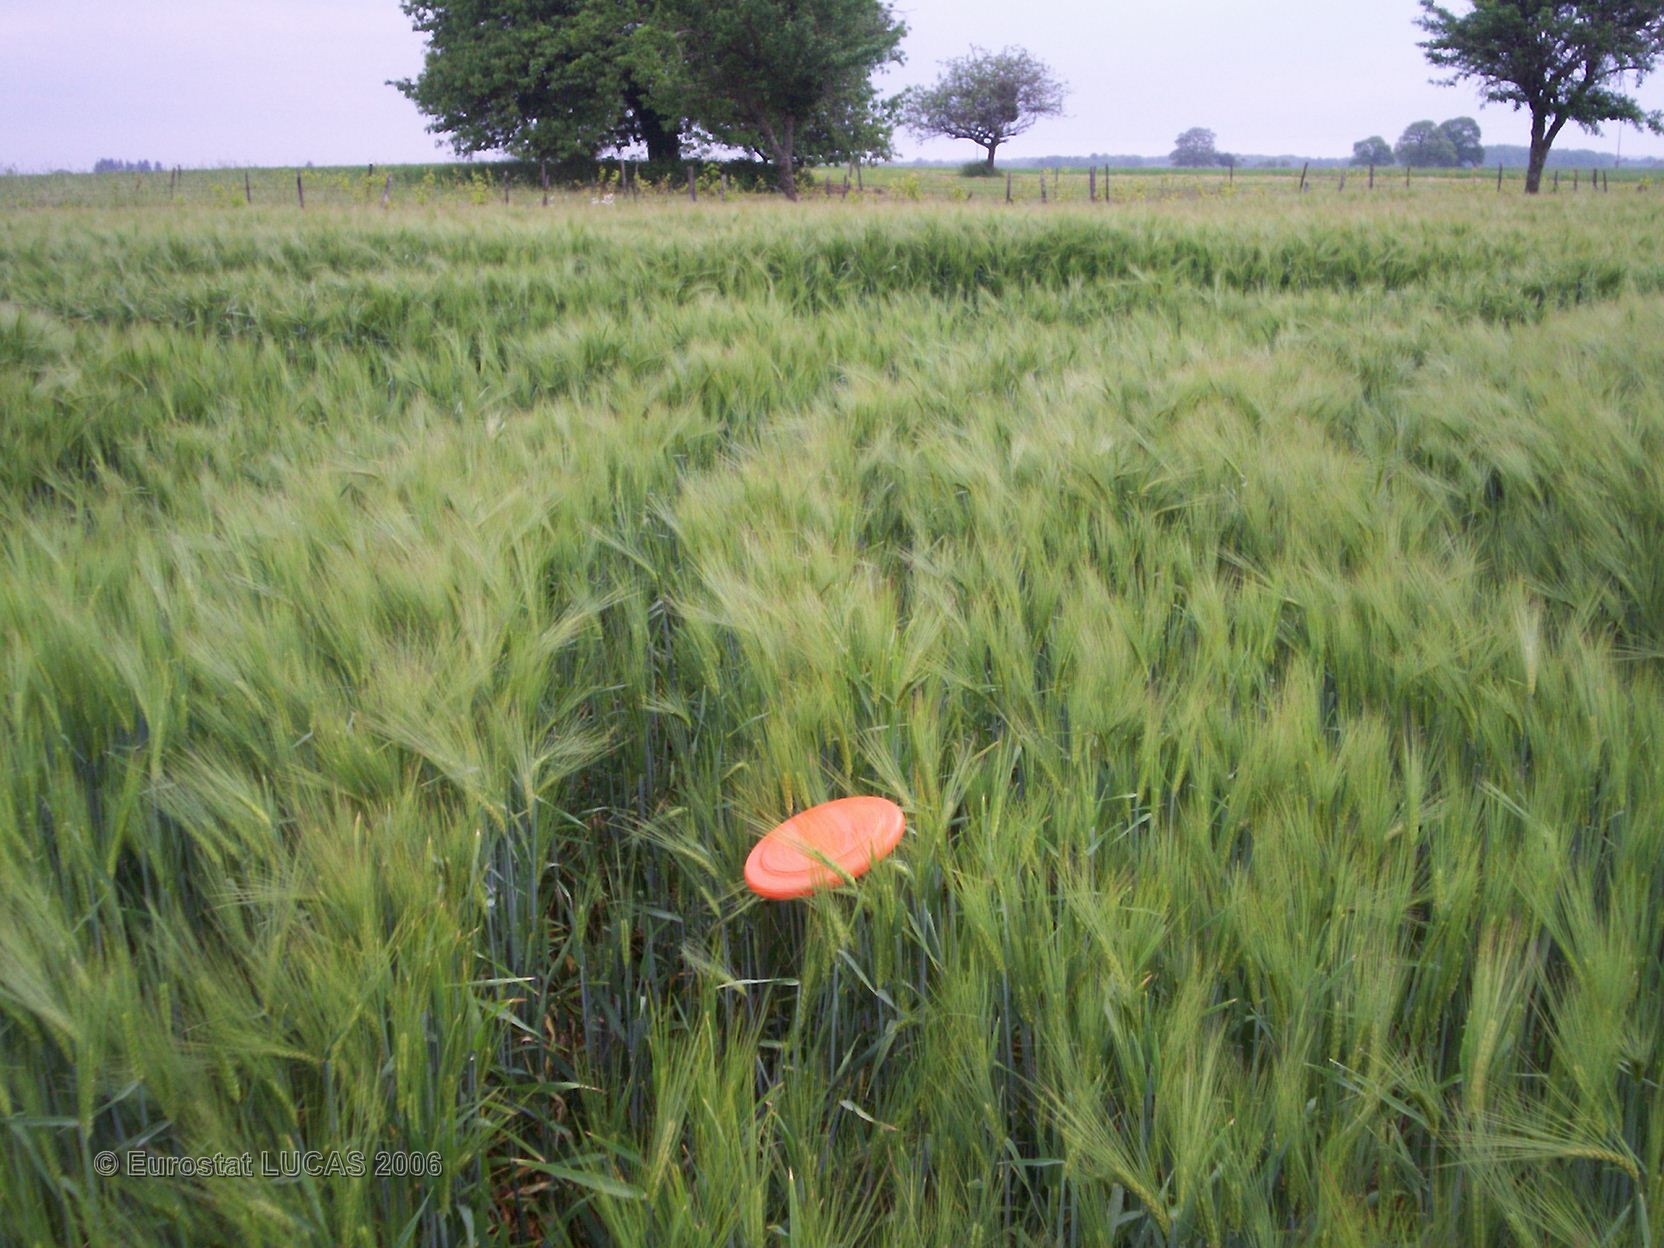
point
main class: Cropland
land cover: Barley
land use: Agriculture (excluding fallow land and kitchen gardens)
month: May
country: FR
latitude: 46.6803
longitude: 1.0305
